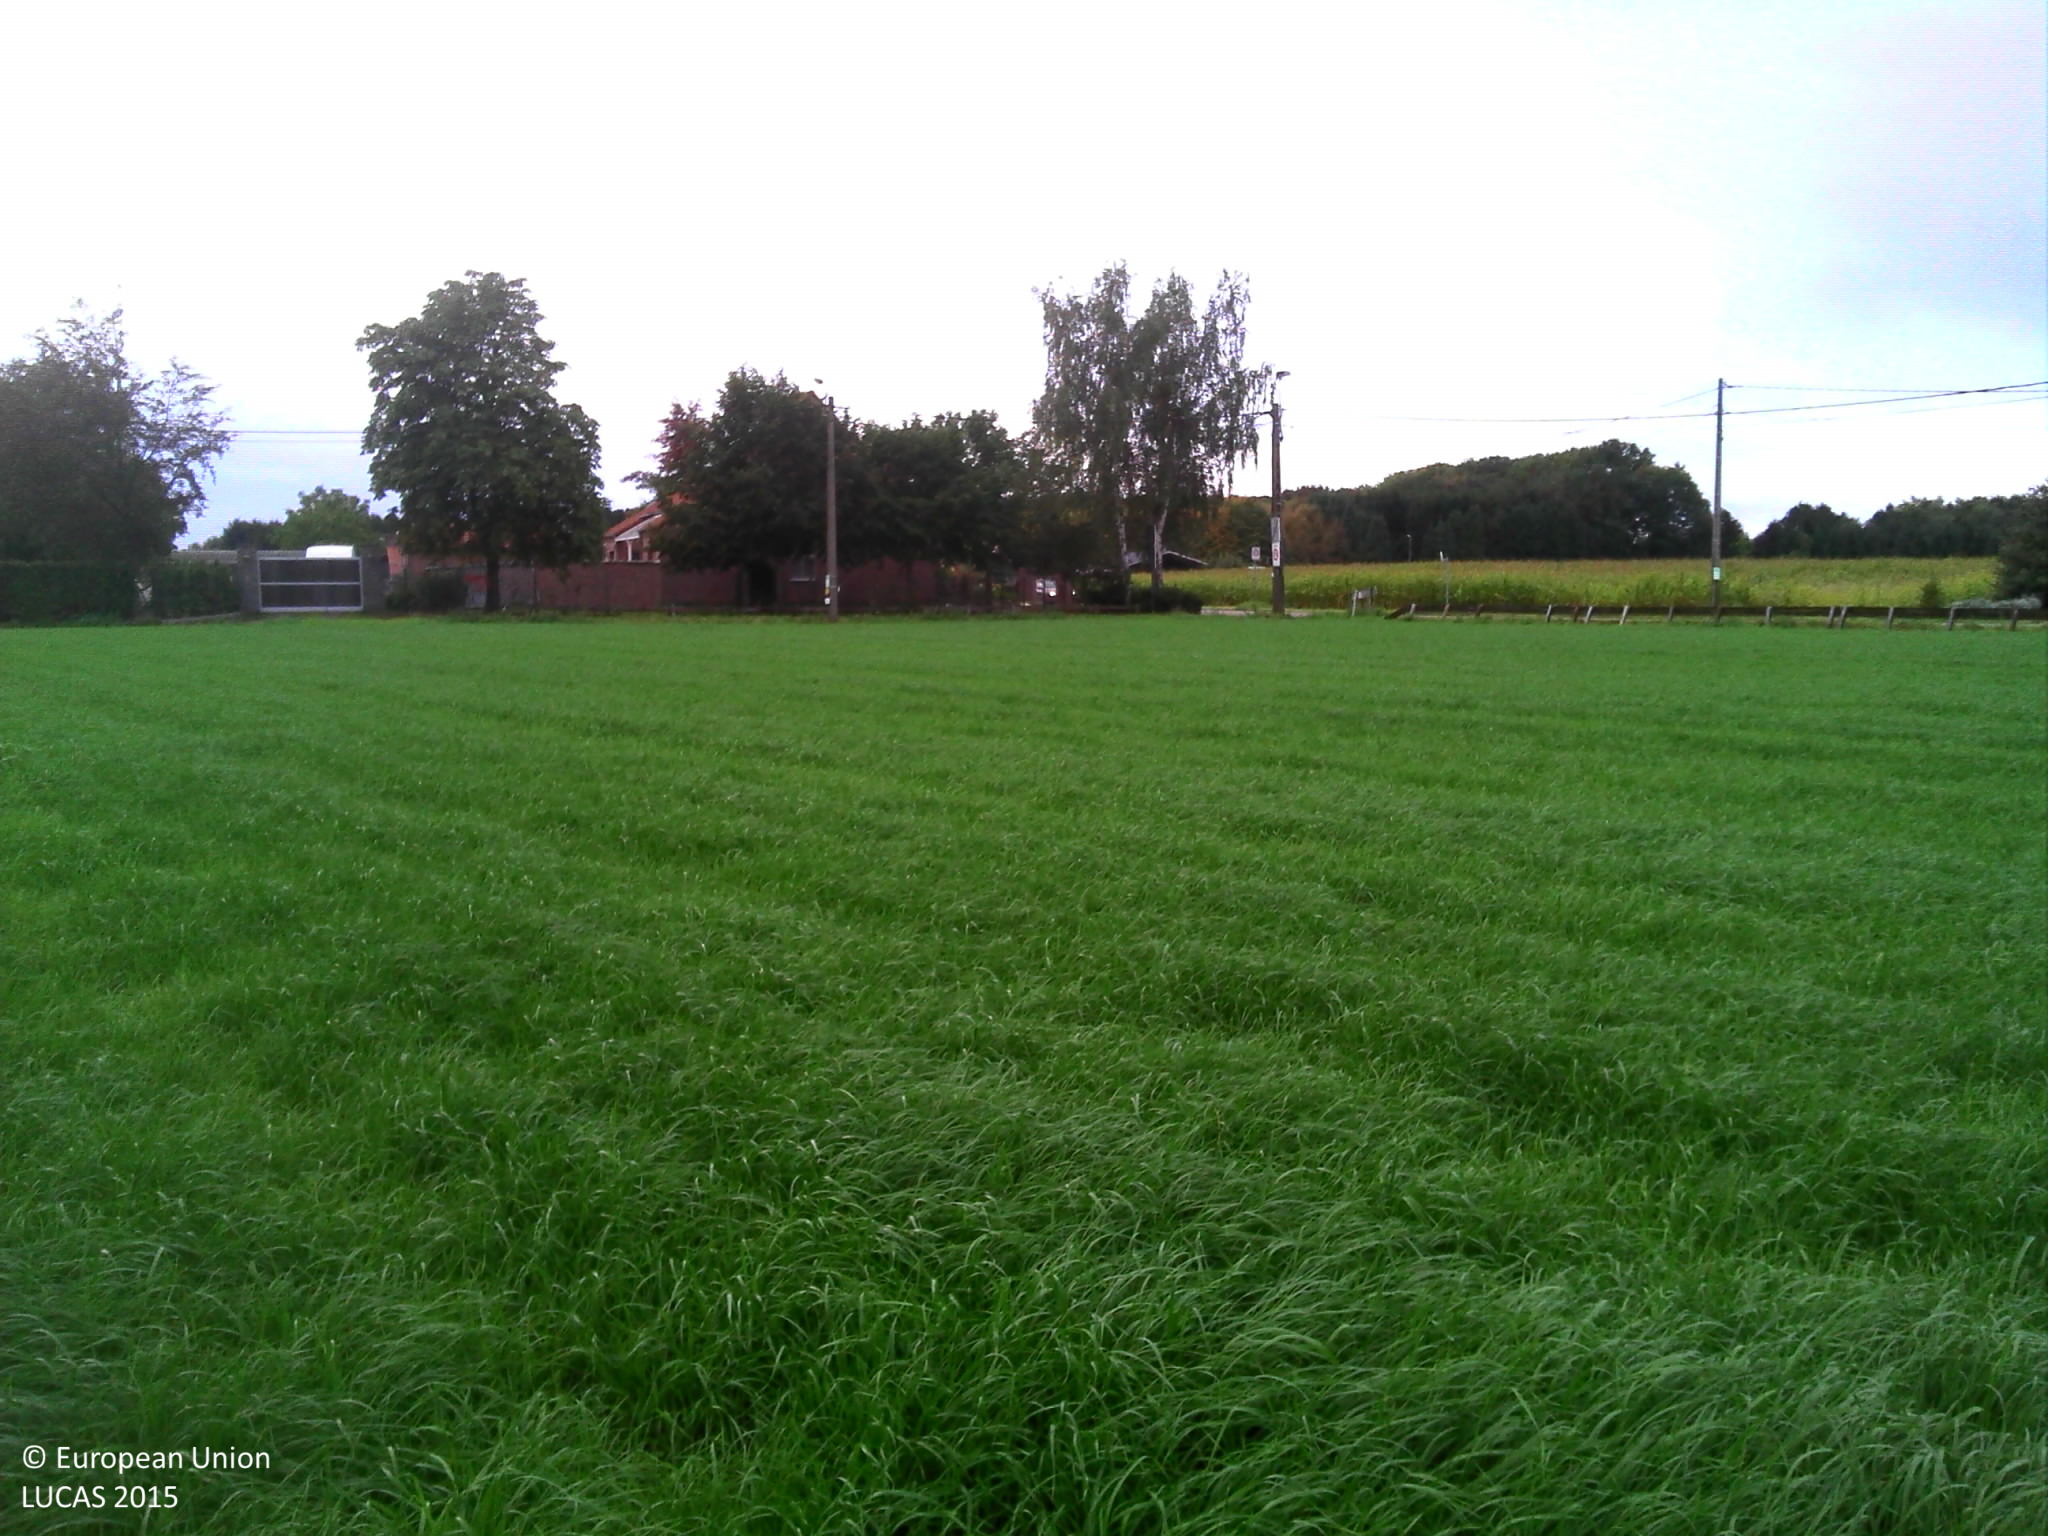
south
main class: Cropland
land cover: Temporary grasslands
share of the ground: > 75 %
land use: Agriculture (excluding fallow land and kitchen gardens)
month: October
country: BE
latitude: 51.0382
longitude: 4.7911
